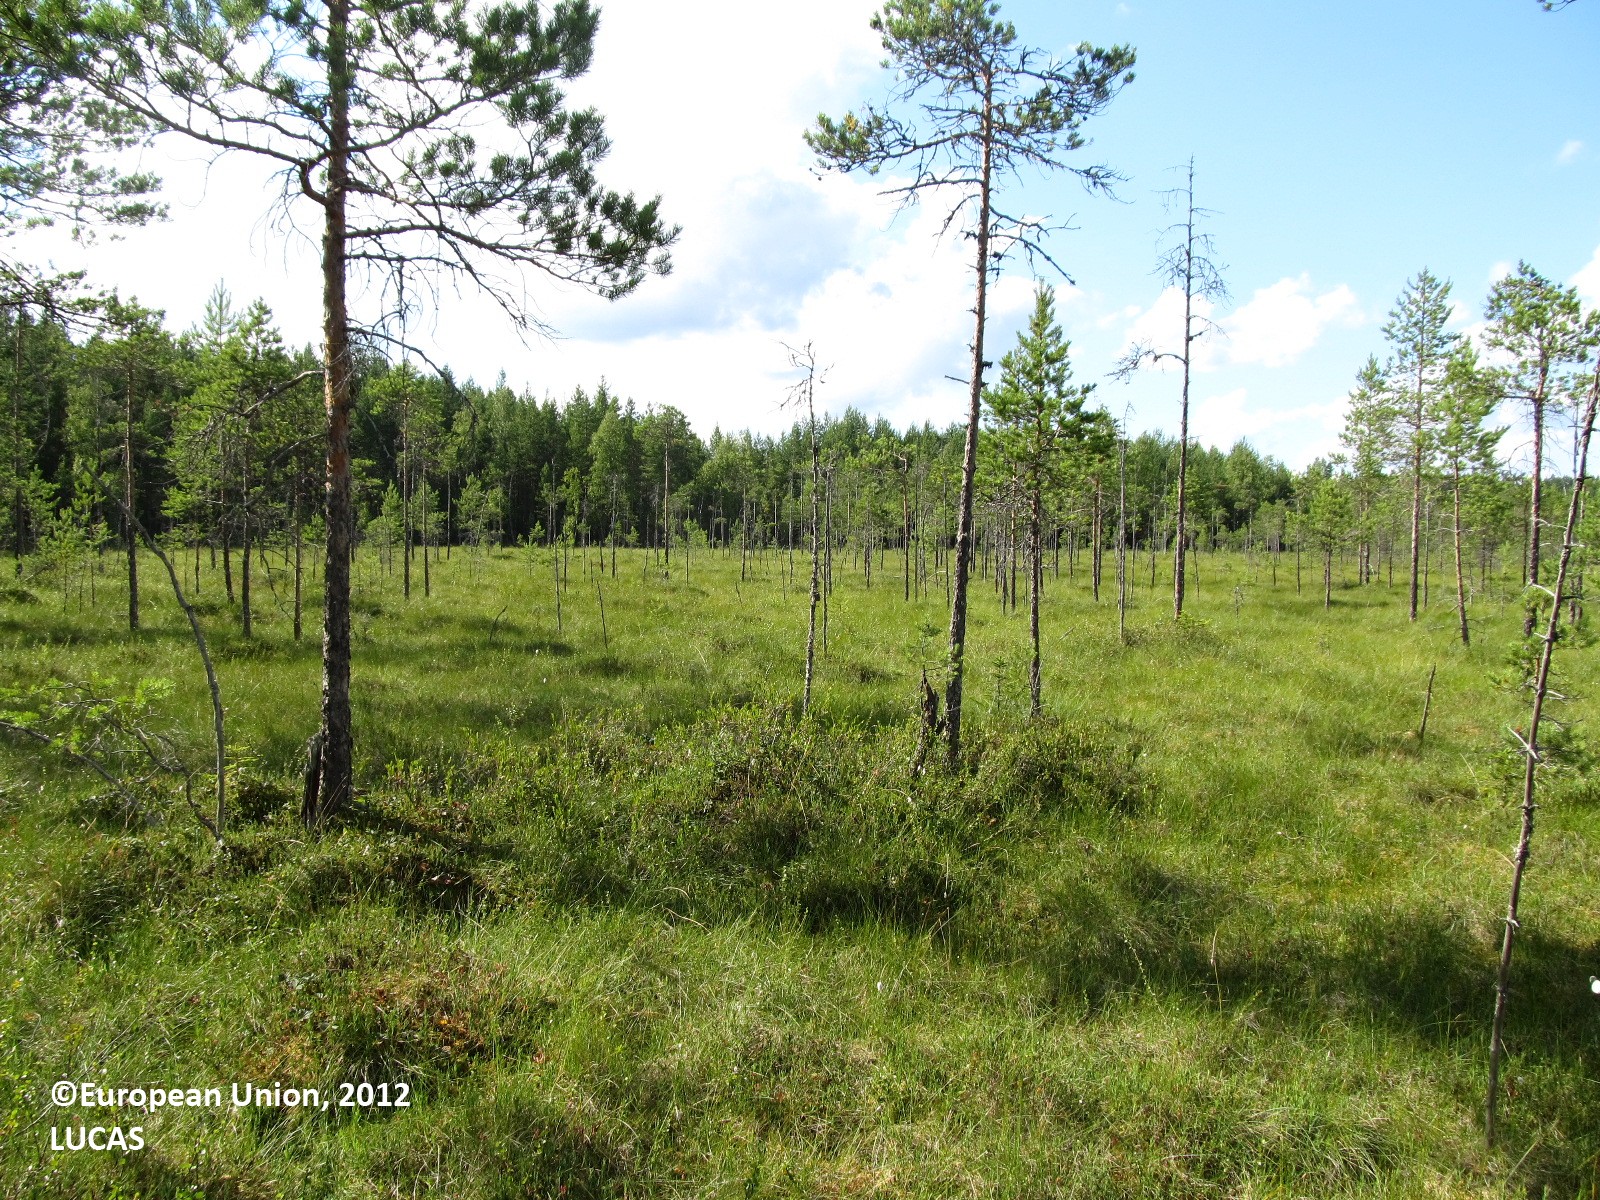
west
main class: Woodland
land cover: Pine dominated coniferous woodland
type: boreal forest
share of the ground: 25 - 50 %
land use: Semi-natural and natural areas not in use
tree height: < 5 m
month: July
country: FI
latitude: 61.9090
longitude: 27.9499
